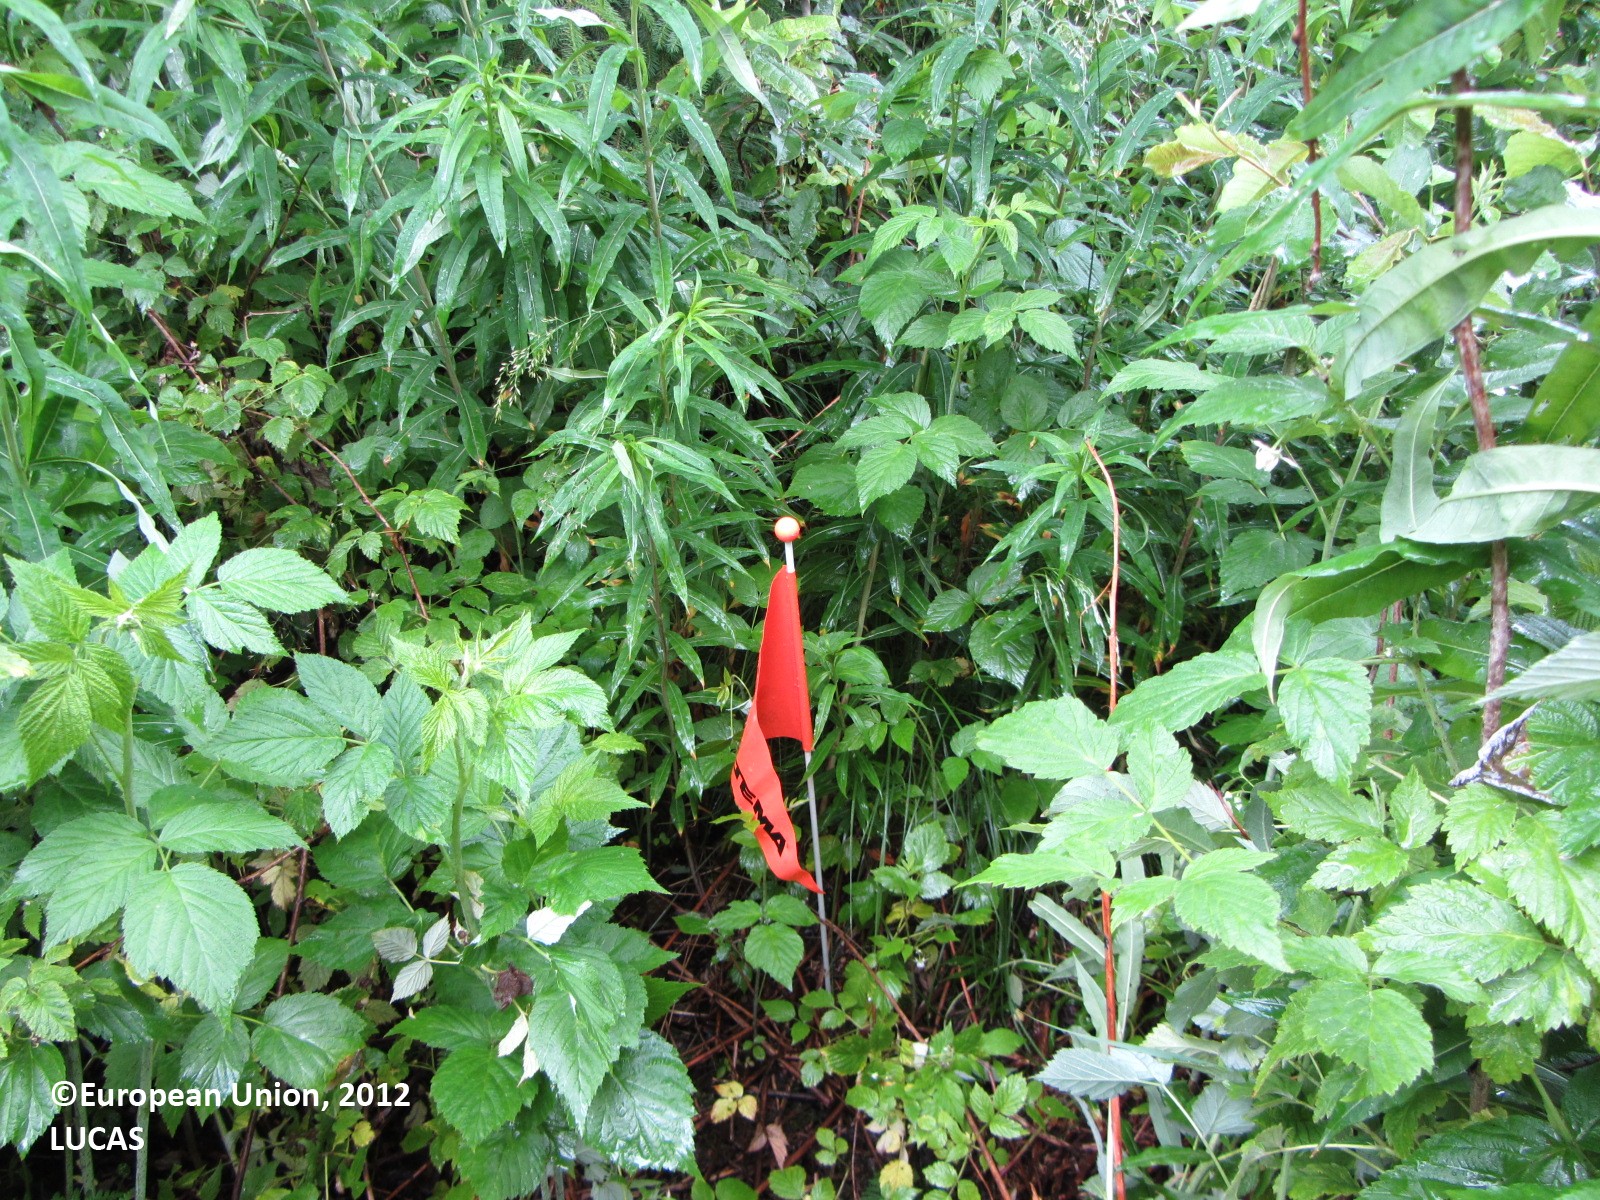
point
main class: Woodland
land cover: Broadleaved woodland
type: boreal forest
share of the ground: 50 - 75 %
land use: Forestry
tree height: > 5 m
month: July
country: FI
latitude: 63.8092
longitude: 25.5532
